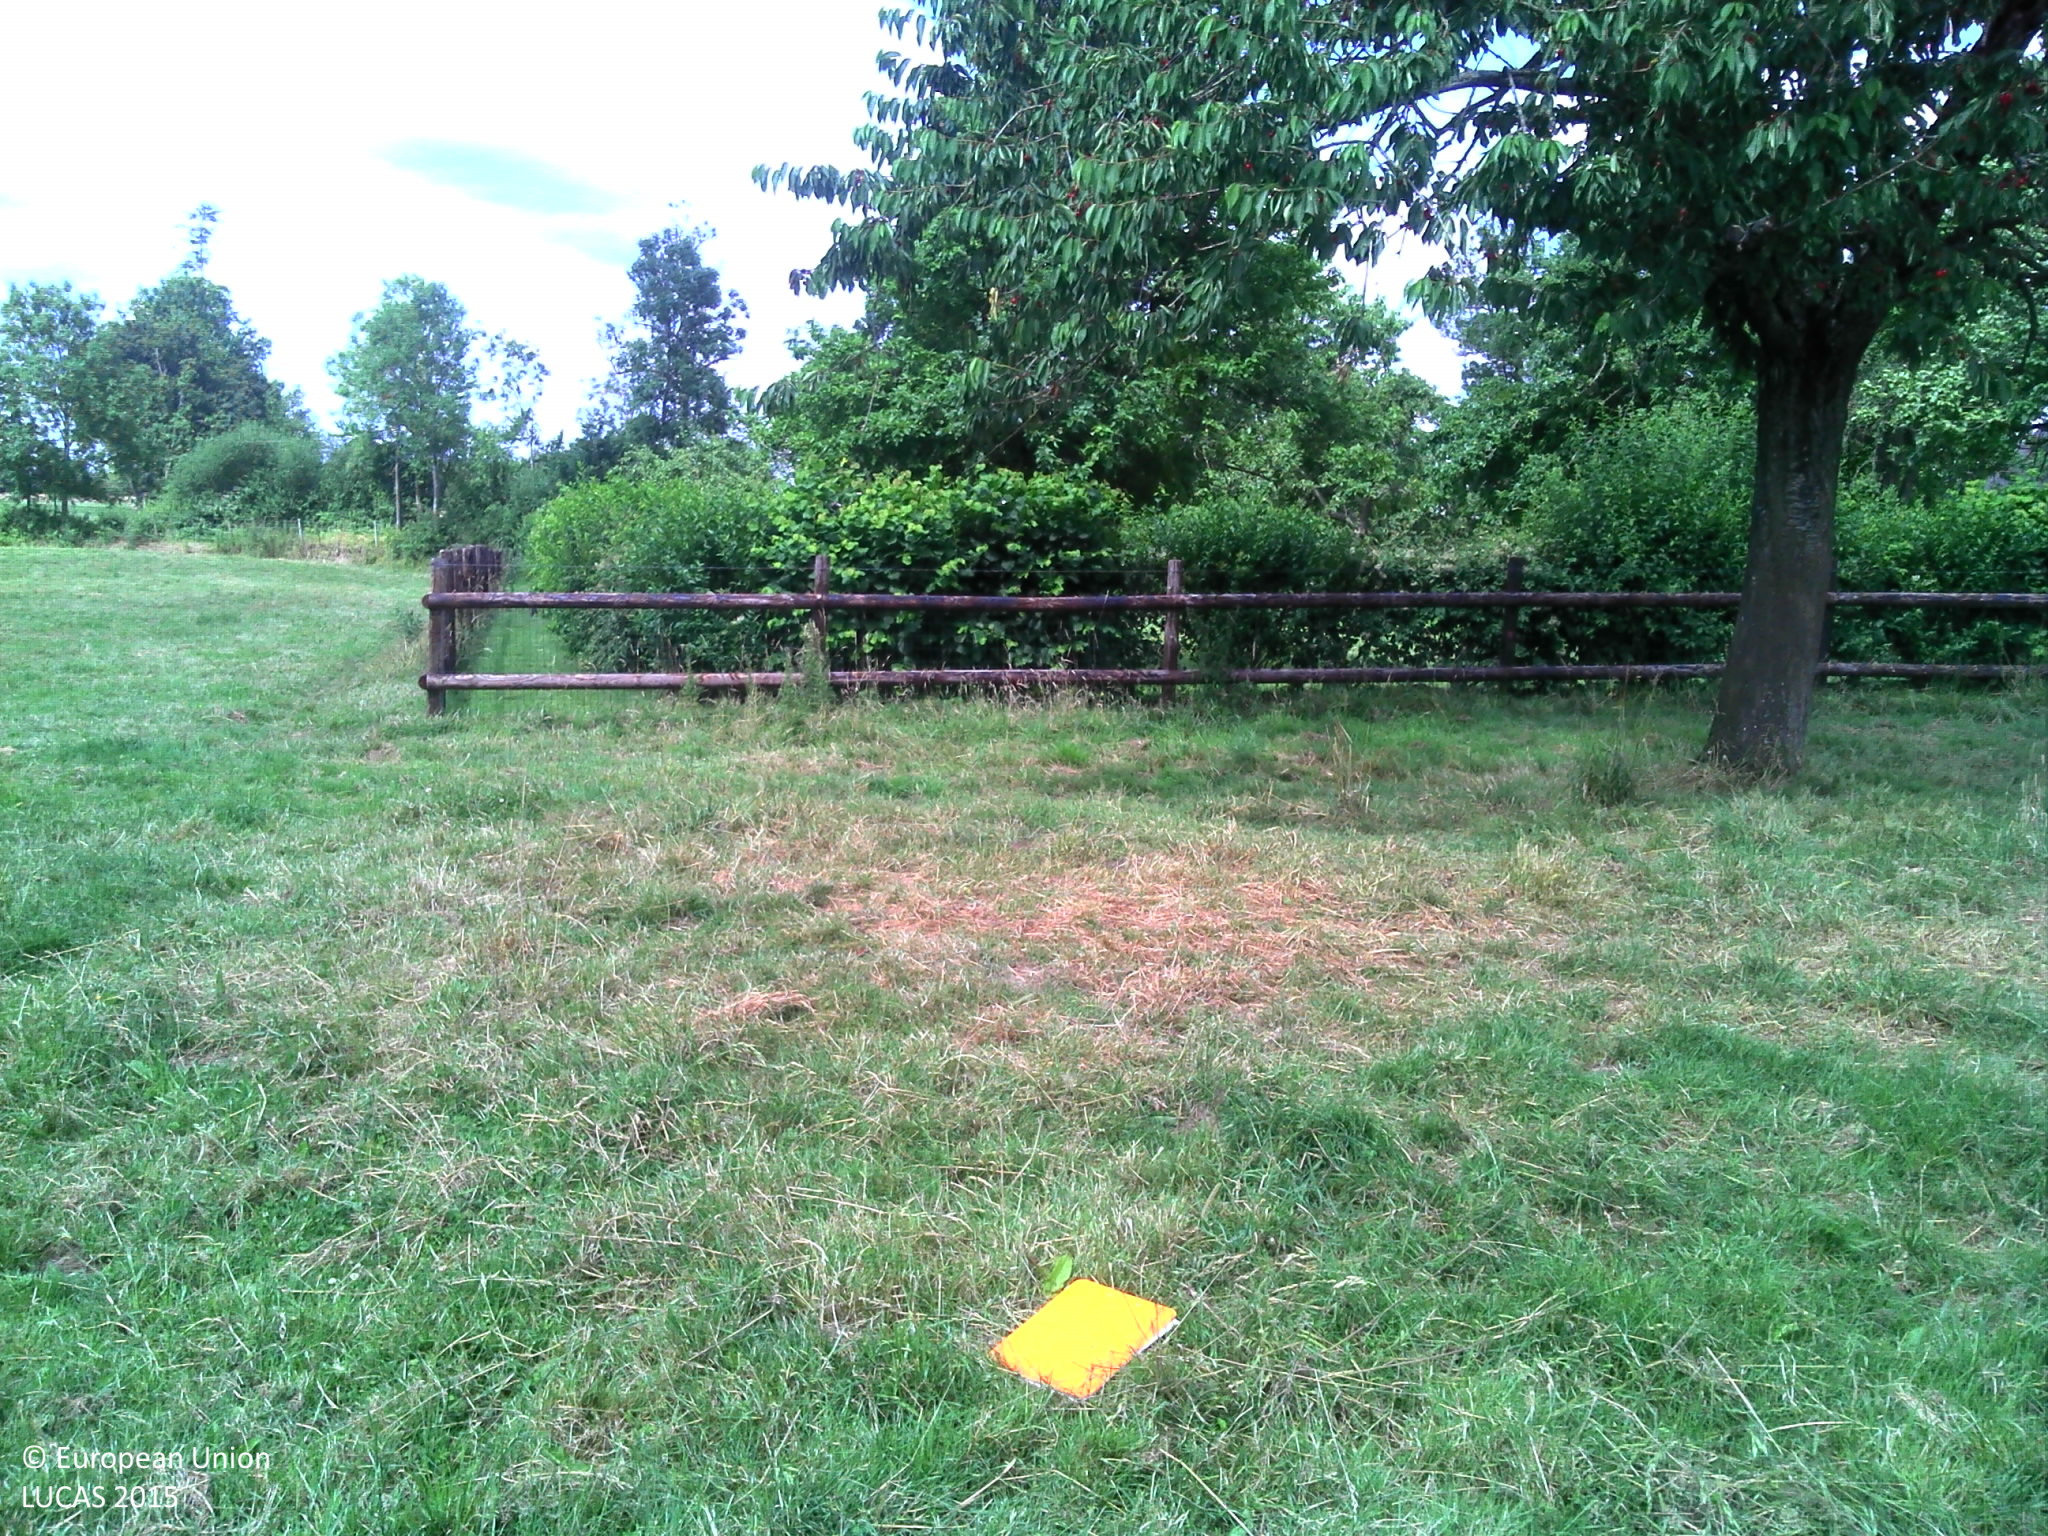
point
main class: Grassland
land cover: Grassland with sparse tree/shrub cover
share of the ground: > 75 %
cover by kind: herbaceous plants 95 %, broadleaved forest trees 5 %
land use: Agriculture (excluding fallow land and kitchen gardens)
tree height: > 5 m
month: July
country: FR
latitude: 49.1281
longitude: 0.4214
